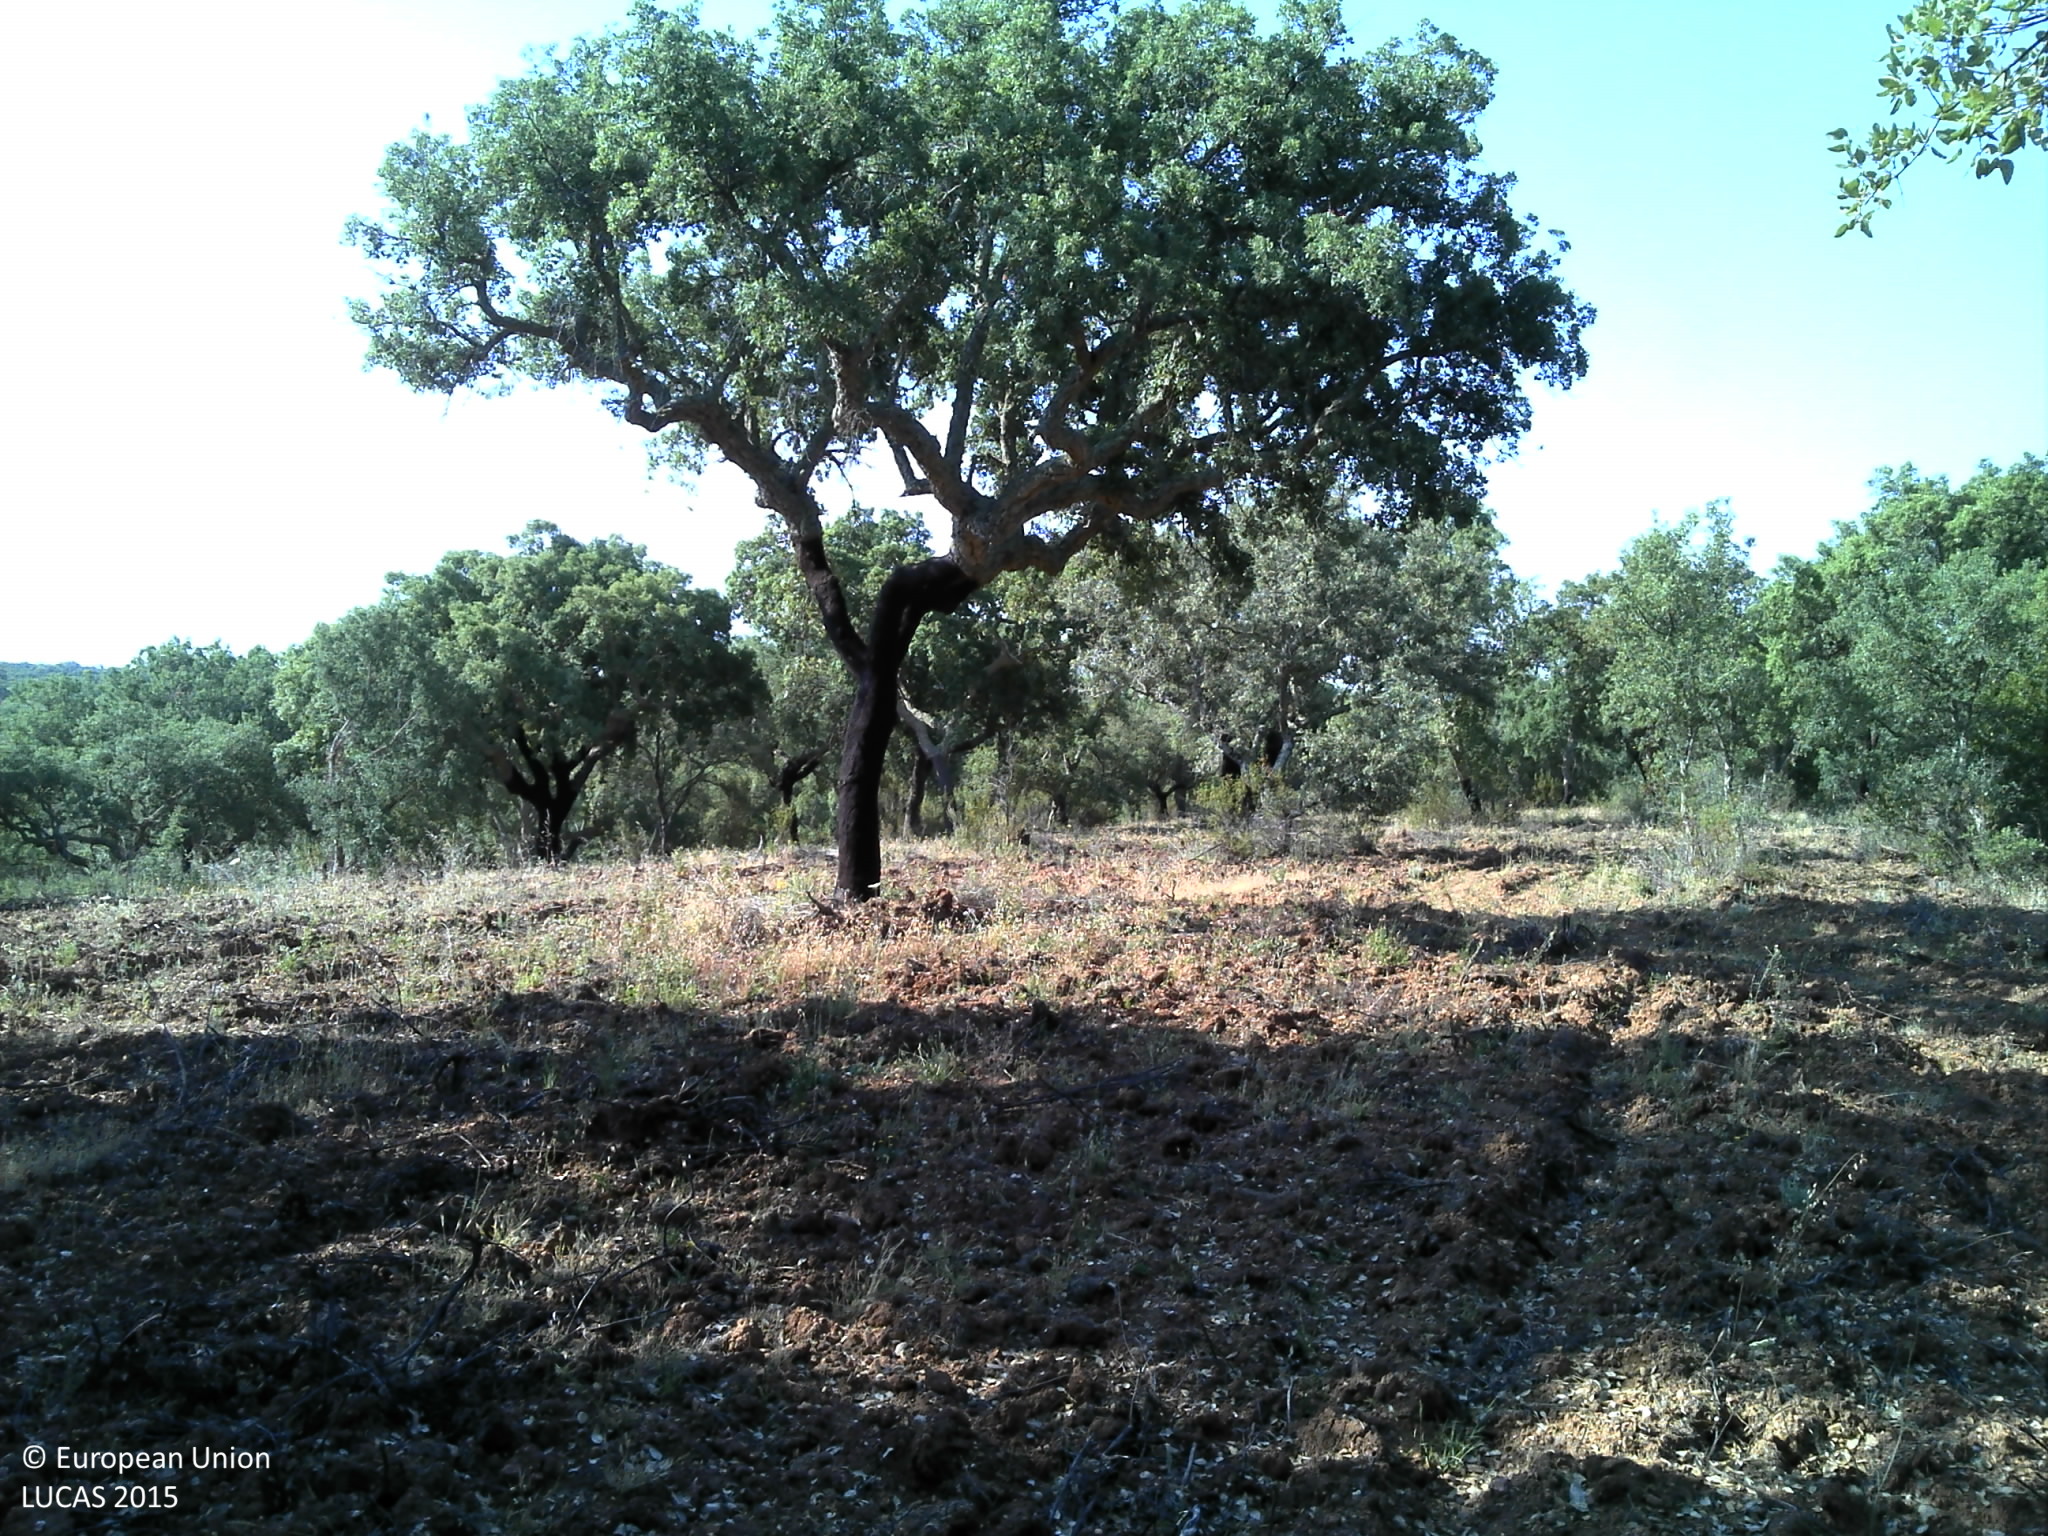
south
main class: Woodland
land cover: Broadleaved woodland
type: broadleaved evergreen forest
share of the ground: 50 - 75 %
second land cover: Spontaneously vegetated surfaces
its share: 10 - 25 %
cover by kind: broadleaved forest trees 60 %, unconsolidated bare surface 25 %, herbaceous plants 15 %
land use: Forestry
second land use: Agriculture (excluding fallow land and kitchen gardens)
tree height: > 5 m
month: May
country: PT
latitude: 38.8863
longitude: -7.7845
